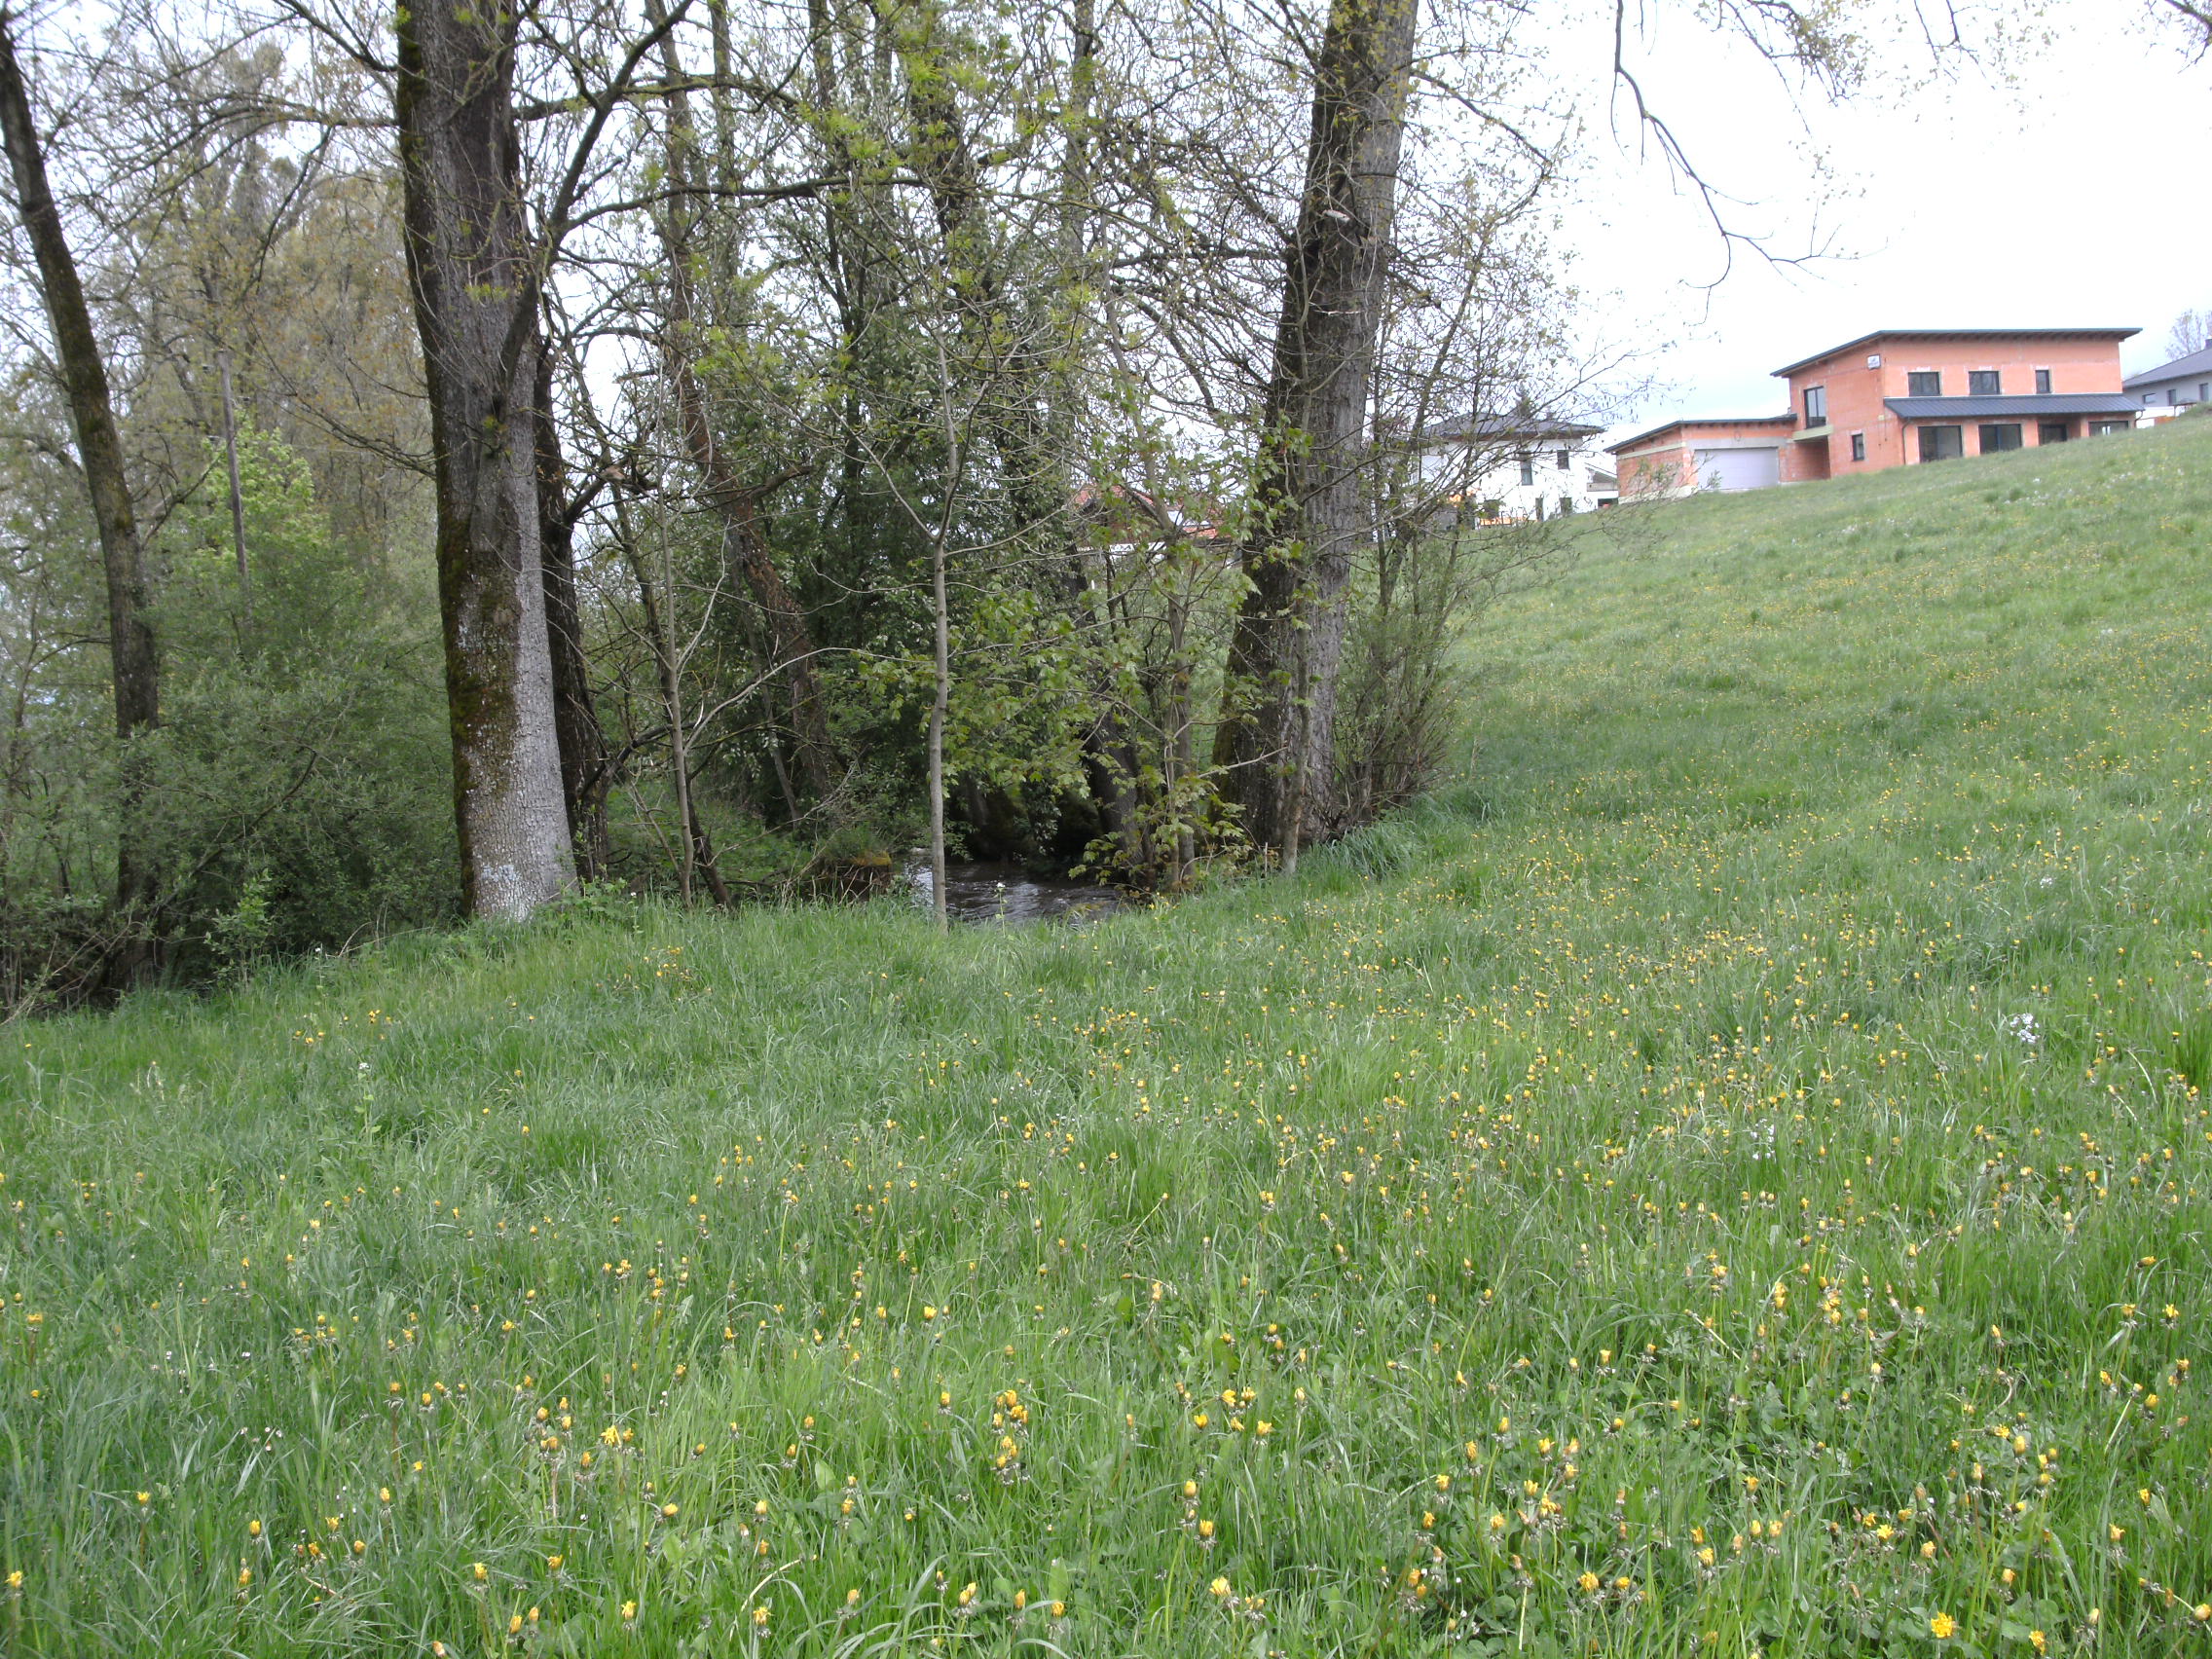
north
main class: Grassland
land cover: Grassland without tree/shrub cover
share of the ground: > 75 %
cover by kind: herbaceous plants 100 %
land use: Agriculture (excluding fallow land and kitchen gardens)
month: May
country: AT
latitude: 48.1686
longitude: 13.4818
